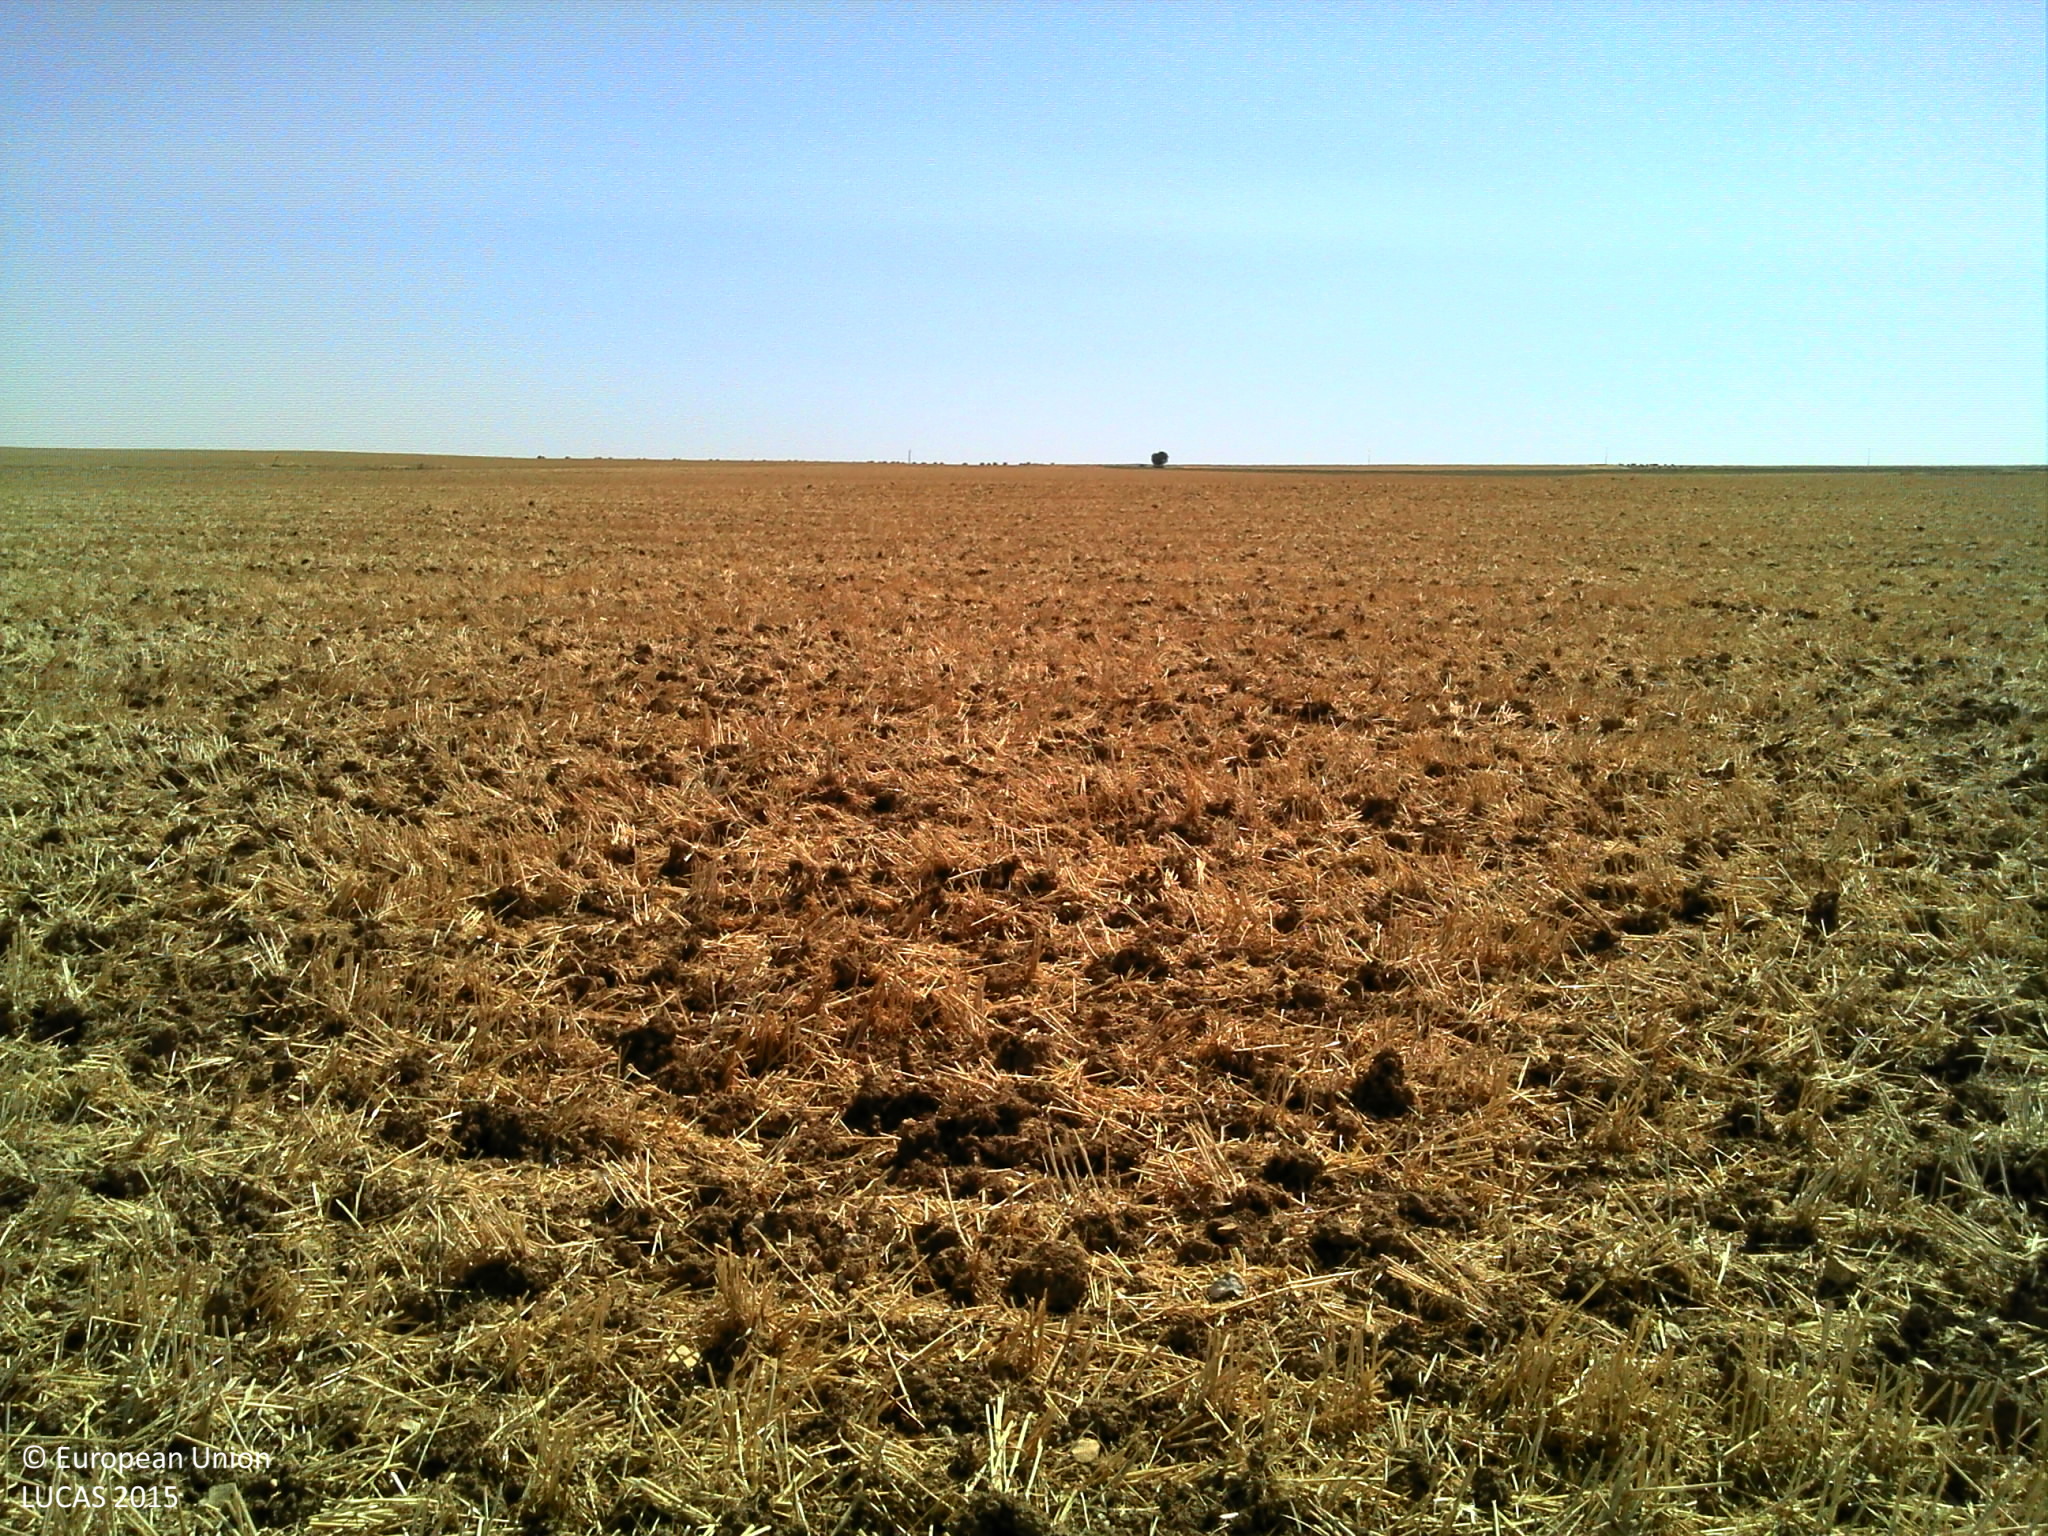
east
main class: Cropland
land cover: Common wheat
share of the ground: > 75 %
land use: Agriculture (excluding fallow land and kitchen gardens)
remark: Tilled/Sowed
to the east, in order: Common wheat
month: August
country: FR
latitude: 47.9384
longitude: 3.4488
